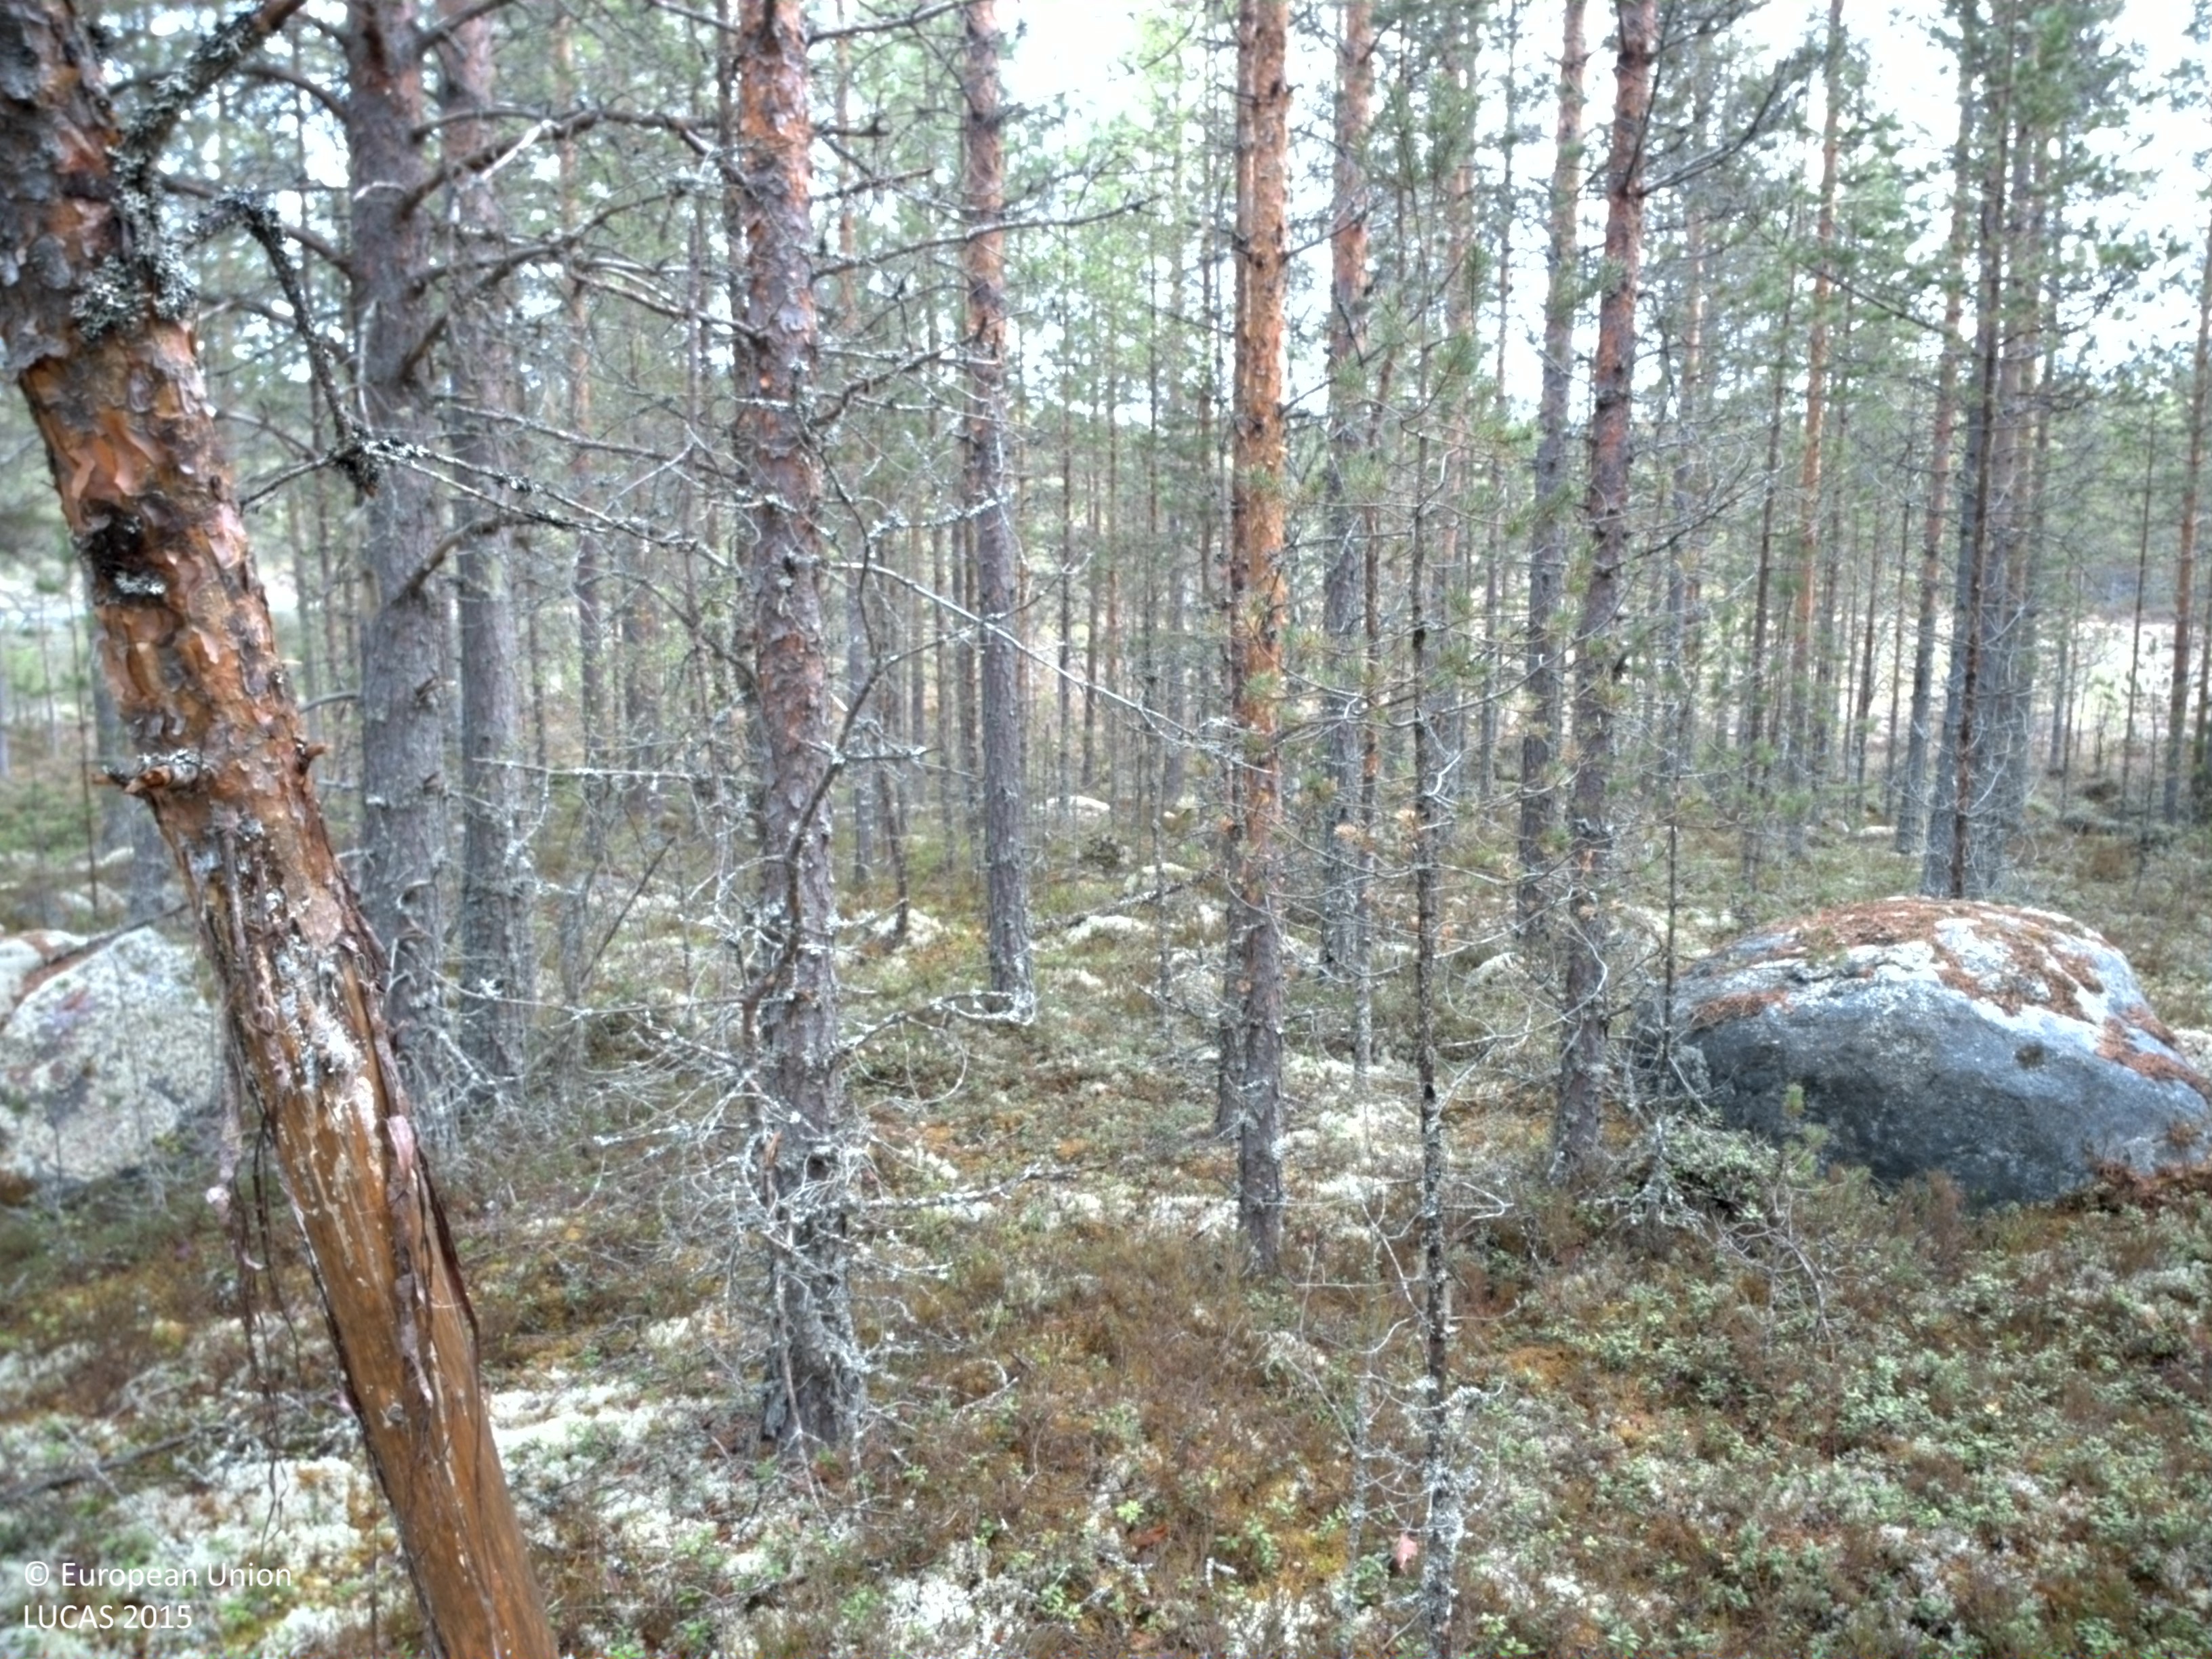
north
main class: Woodland
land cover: Pine dominated coniferous woodland
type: boreal forest
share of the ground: 50 - 75 %
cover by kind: coniferous forest trees 65 %, herbaceous plants 30 %, lichens and mosses 5 %
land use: Forestry
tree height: > 5 m
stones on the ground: < 10 %
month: May
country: SE
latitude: 61.2132
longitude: 15.4395
